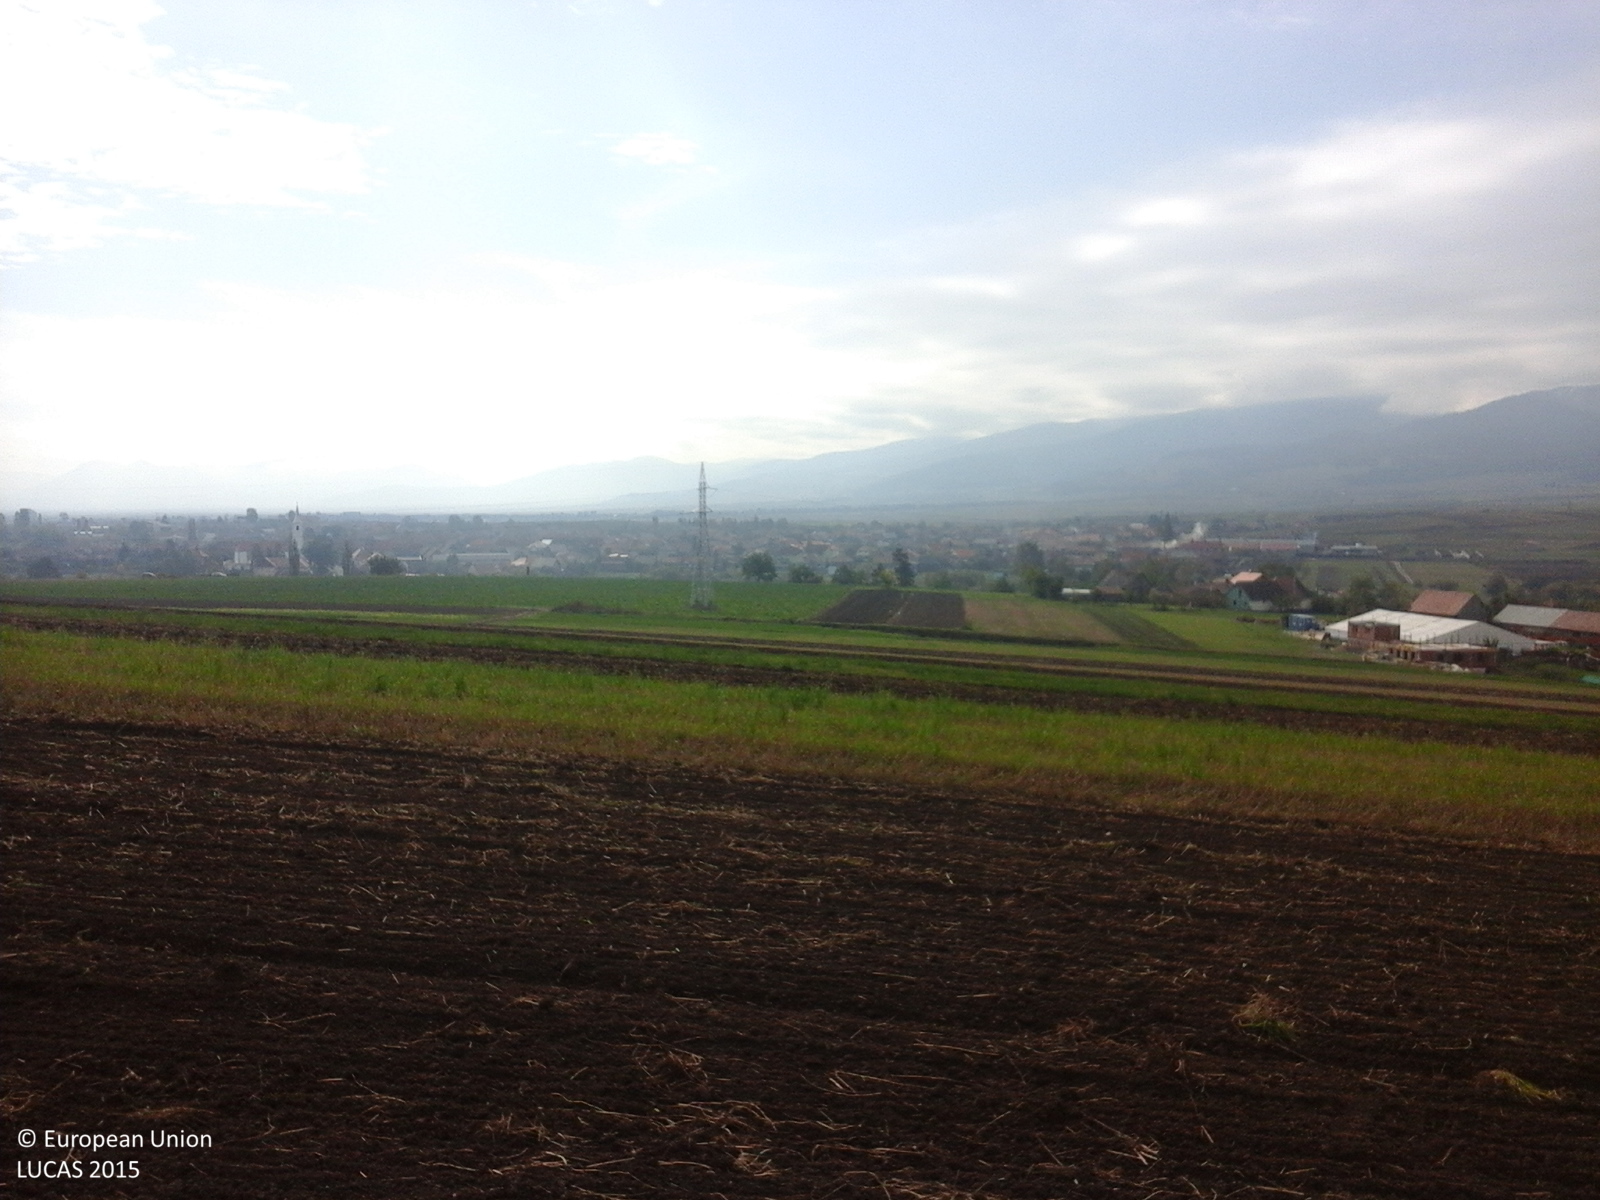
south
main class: Grassland
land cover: Grassland without tree/shrub cover
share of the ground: > 75 %
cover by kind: herbaceous plants 100 %
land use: Agriculture (excluding fallow land and kitchen gardens)
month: October
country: RO
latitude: 46.3165
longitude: 25.8425
